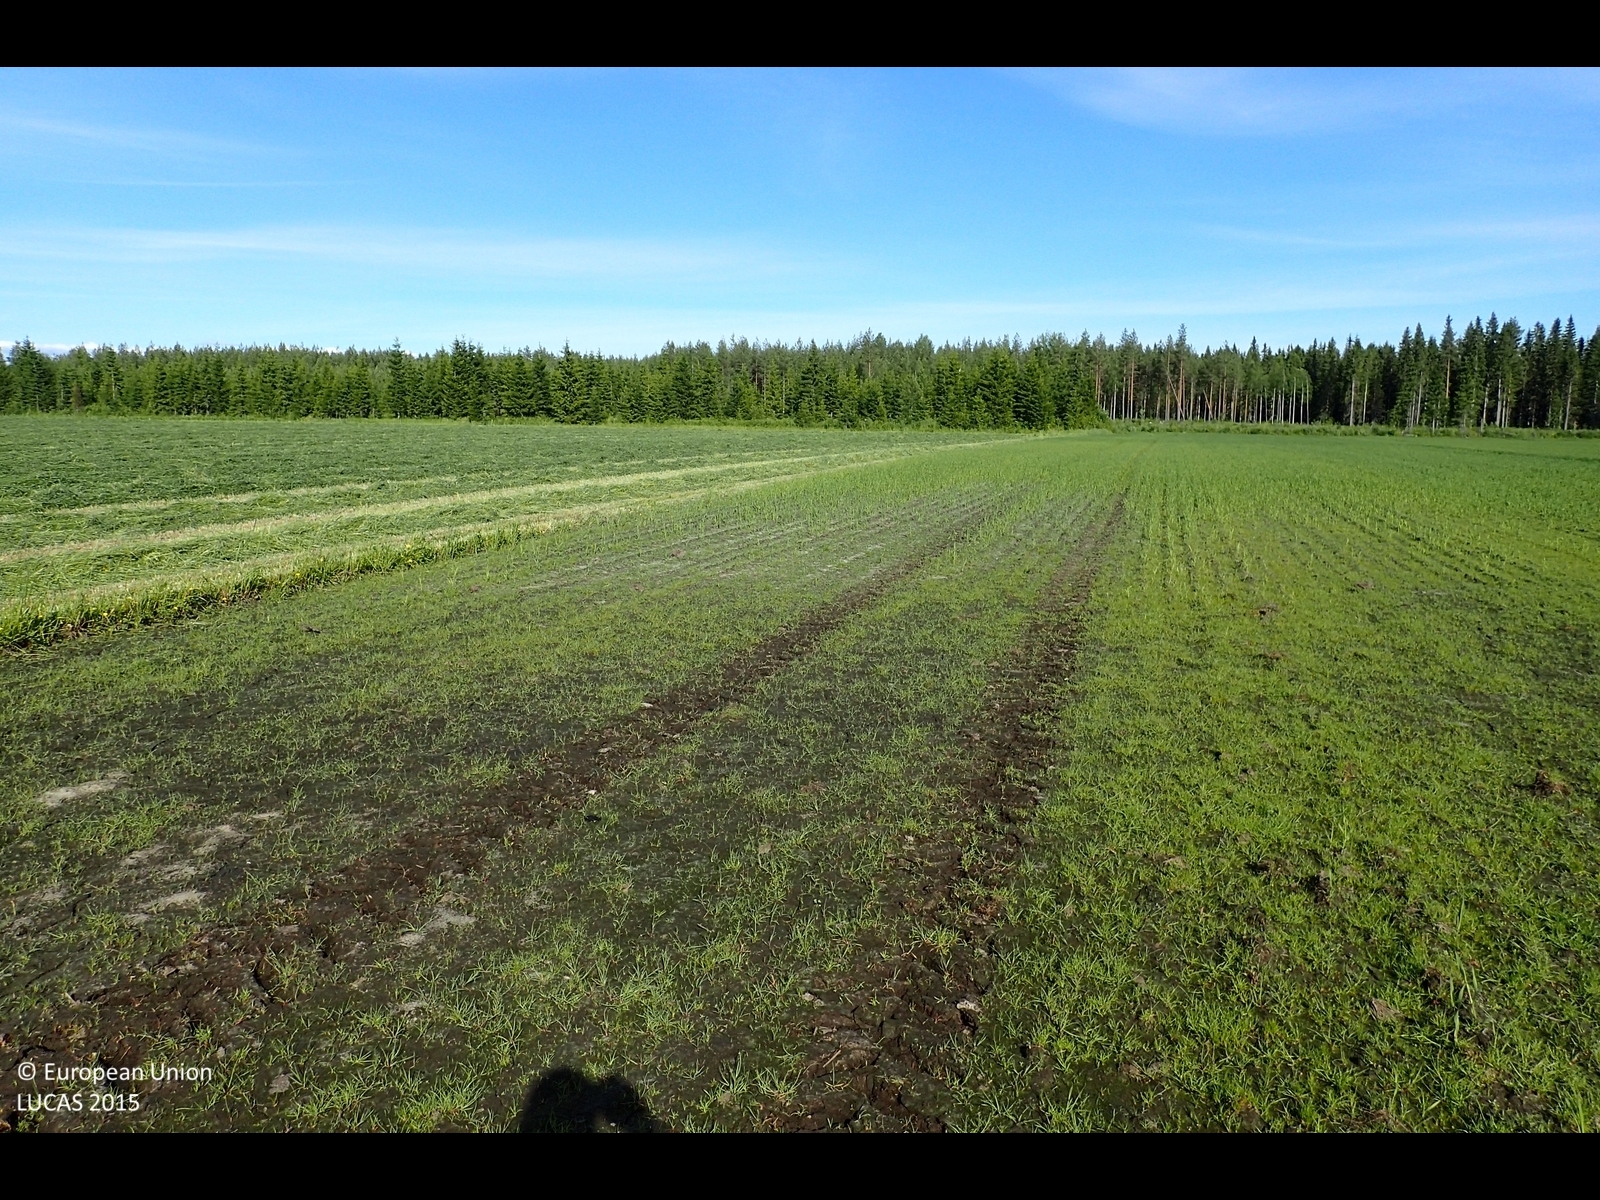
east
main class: Cropland
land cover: Oats
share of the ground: > 75 %
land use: Agriculture (excluding fallow land and kitchen gardens)
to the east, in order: Oats; Temporary grasslands; Shruby margins; Ditches and canals; Spruce dominated coniferous woodland; Ditches and canals; Grassland with sparse tree/shrub cover
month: July
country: FI
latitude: 62.5775
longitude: 21.6640
